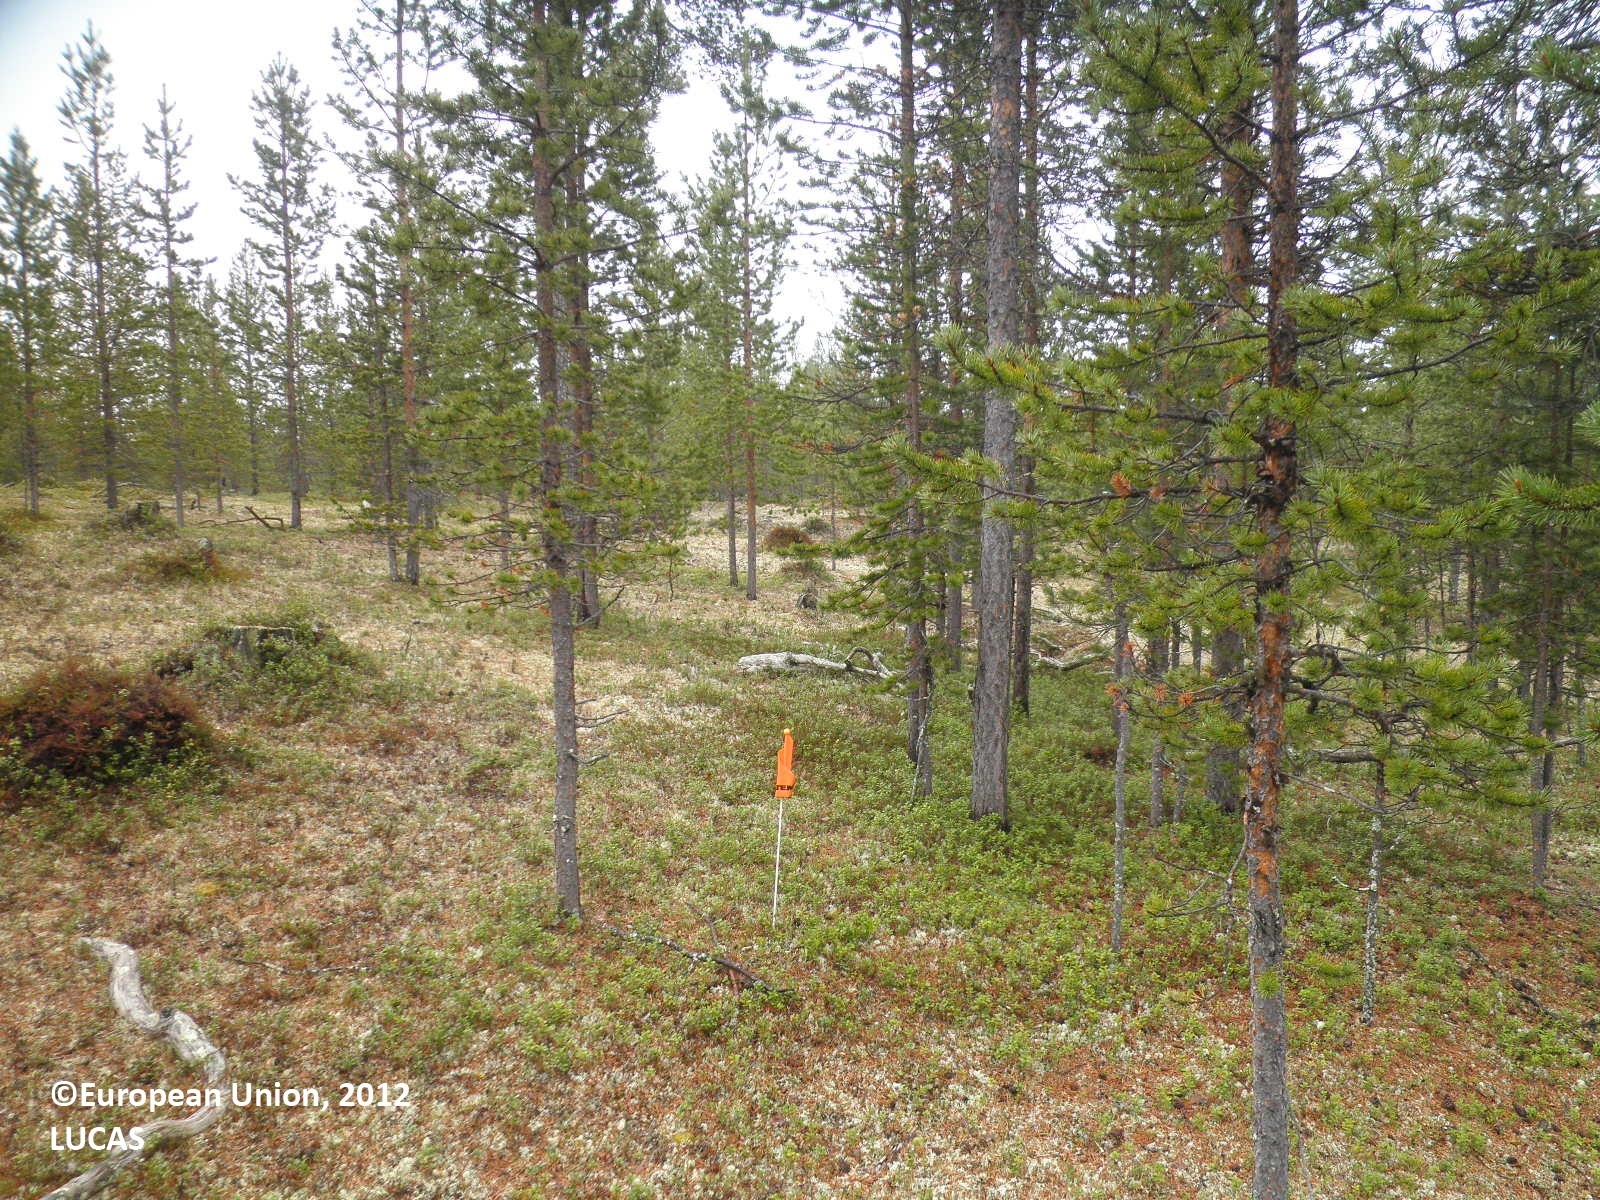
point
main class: Woodland
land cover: Pine dominated coniferous woodland
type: boreal forest
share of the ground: > 75 %
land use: Forestry
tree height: > 5 m
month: June
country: FI
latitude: 69.0768
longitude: 27.0441
